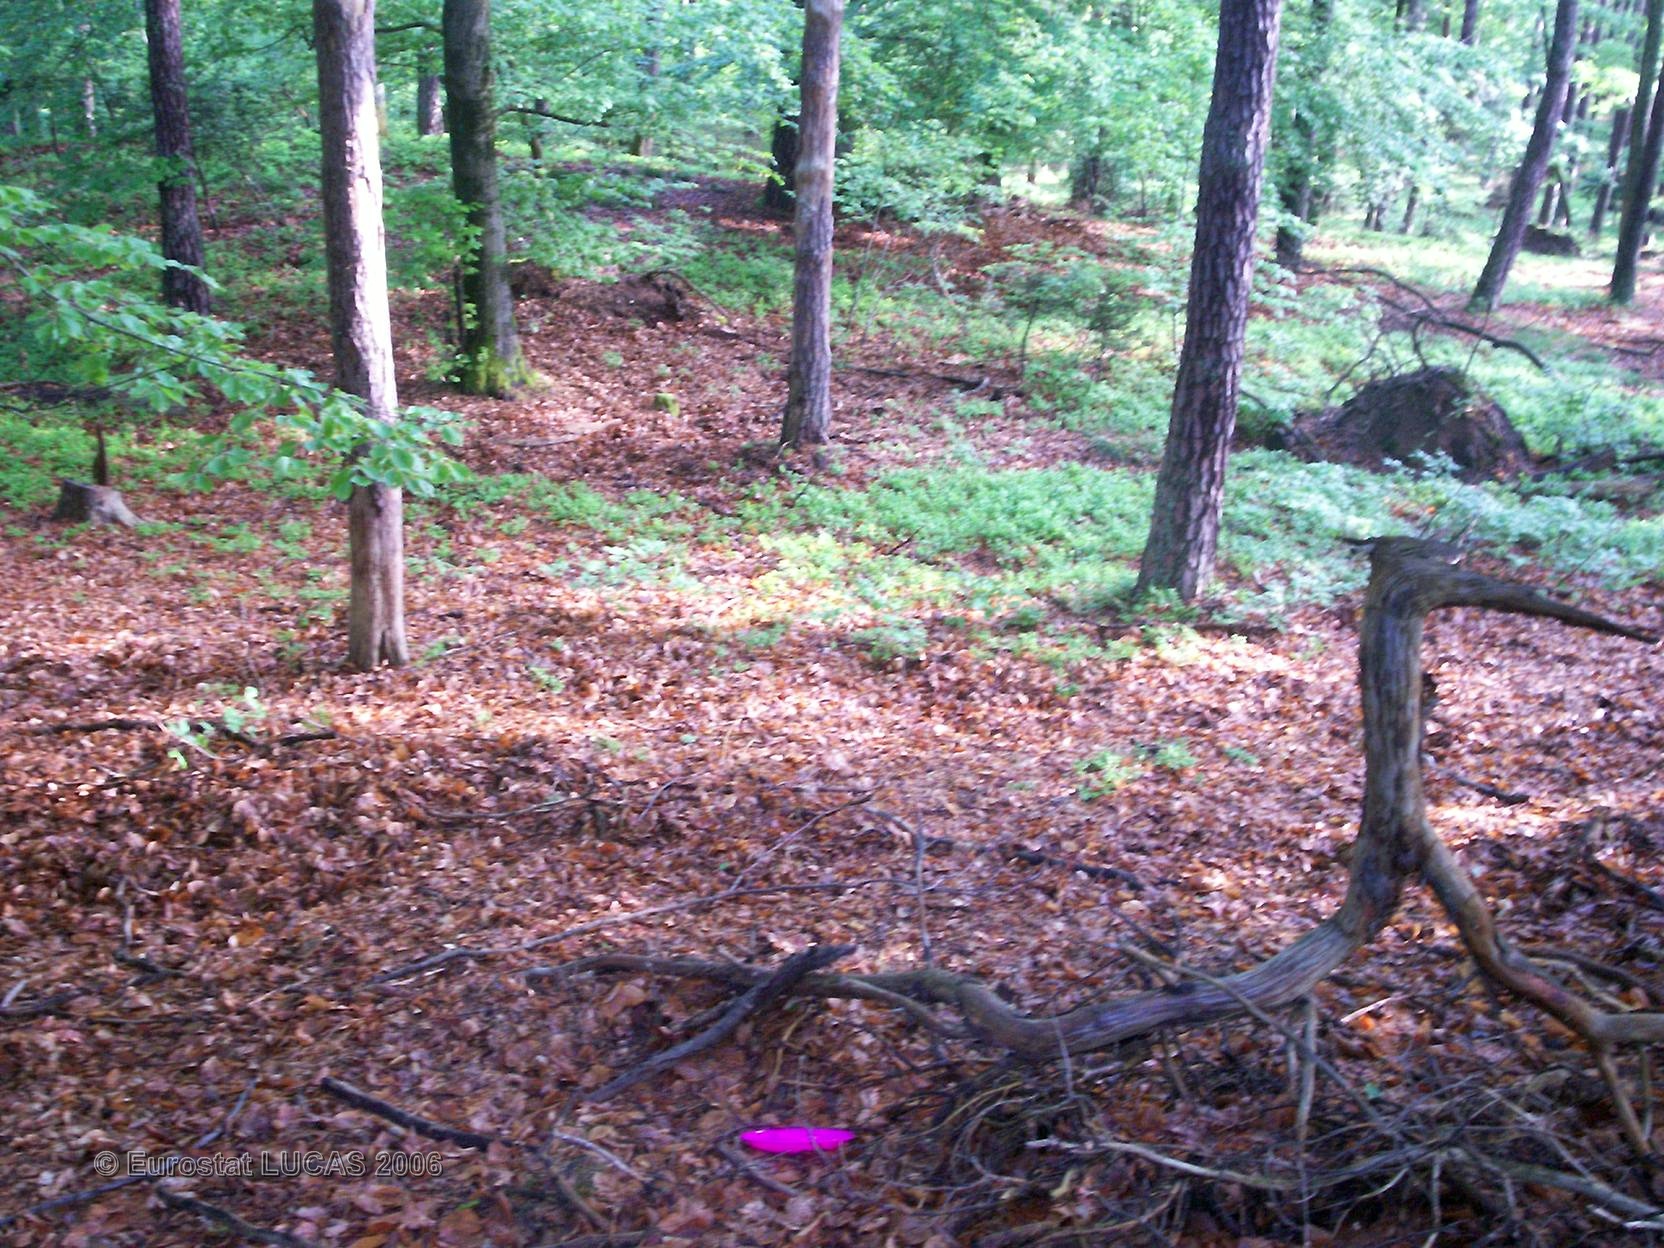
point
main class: Woodland
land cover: Mixed forest
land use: Forestry
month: May
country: FR
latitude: 48.3369
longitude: 7.3973
